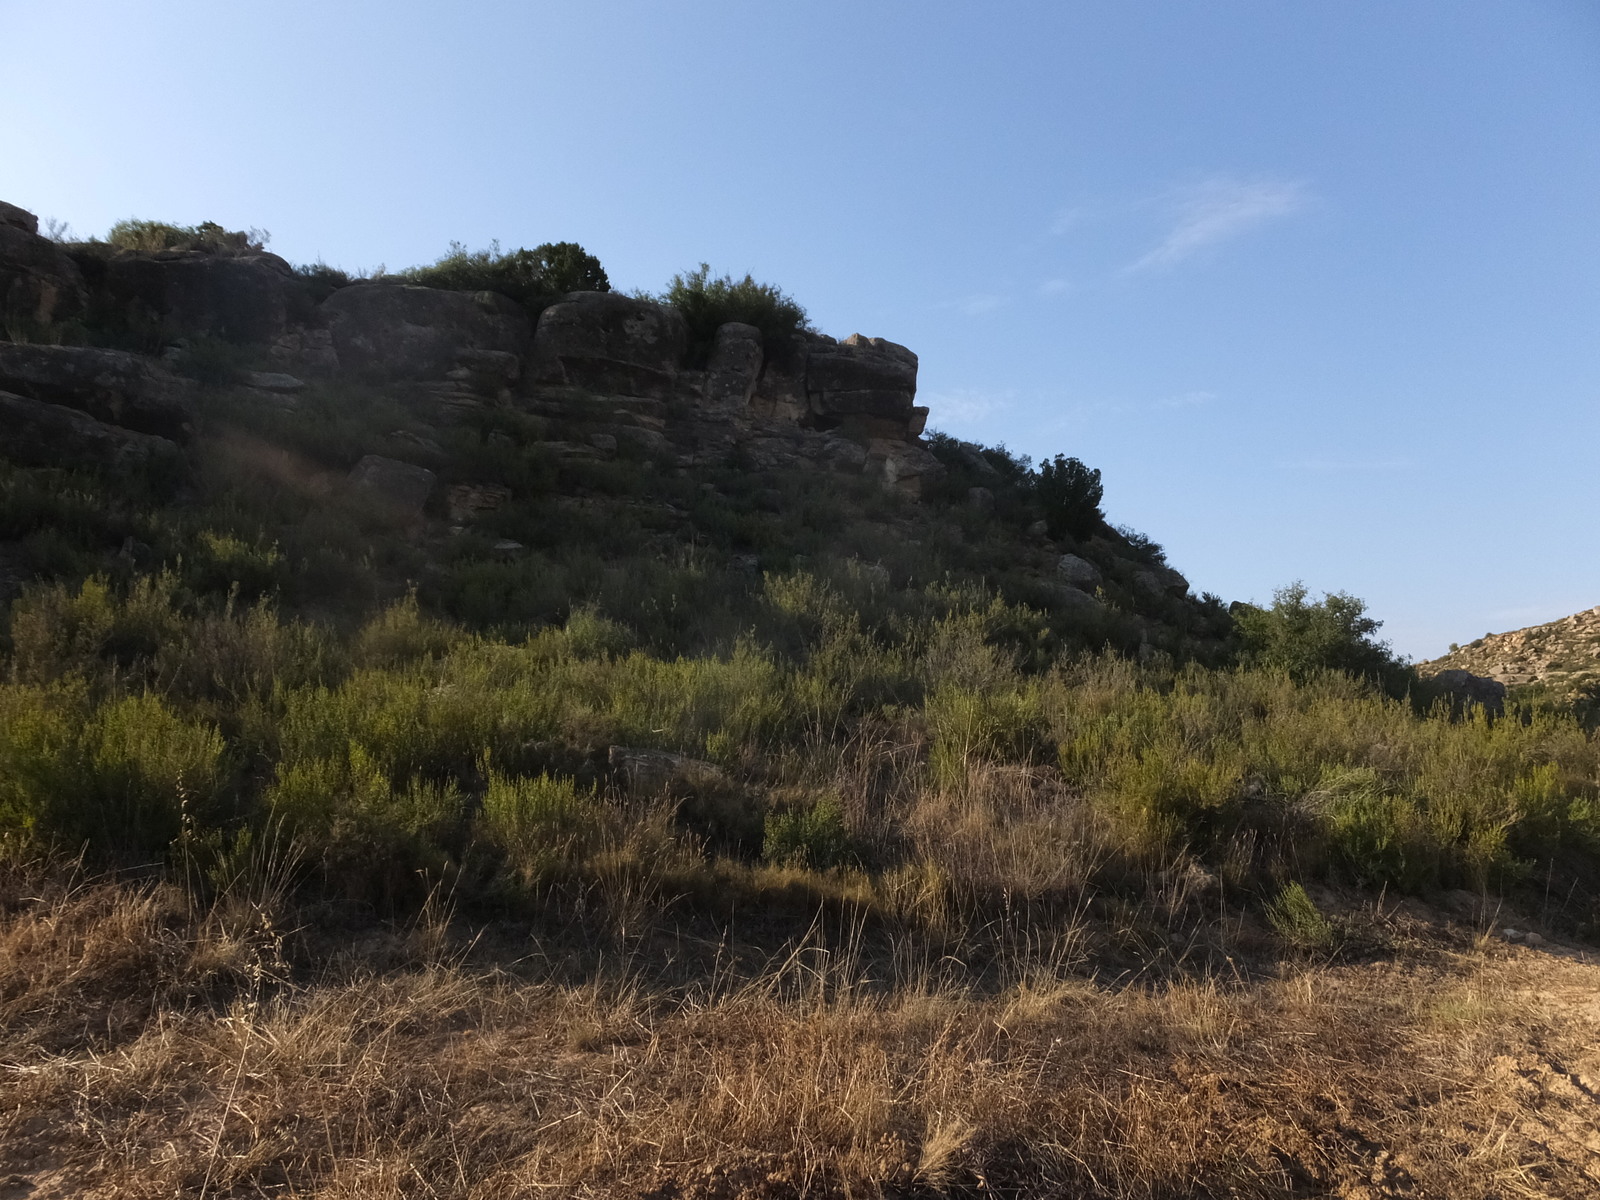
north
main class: Cropland
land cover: Olive groves
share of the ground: 50 - 75 %
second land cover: Other bare soil
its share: > 75 %
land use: Agriculture (excluding fallow land and kitchen gardens)
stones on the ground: < 10 %
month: July
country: ES
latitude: 41.0990
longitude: 0.1431
